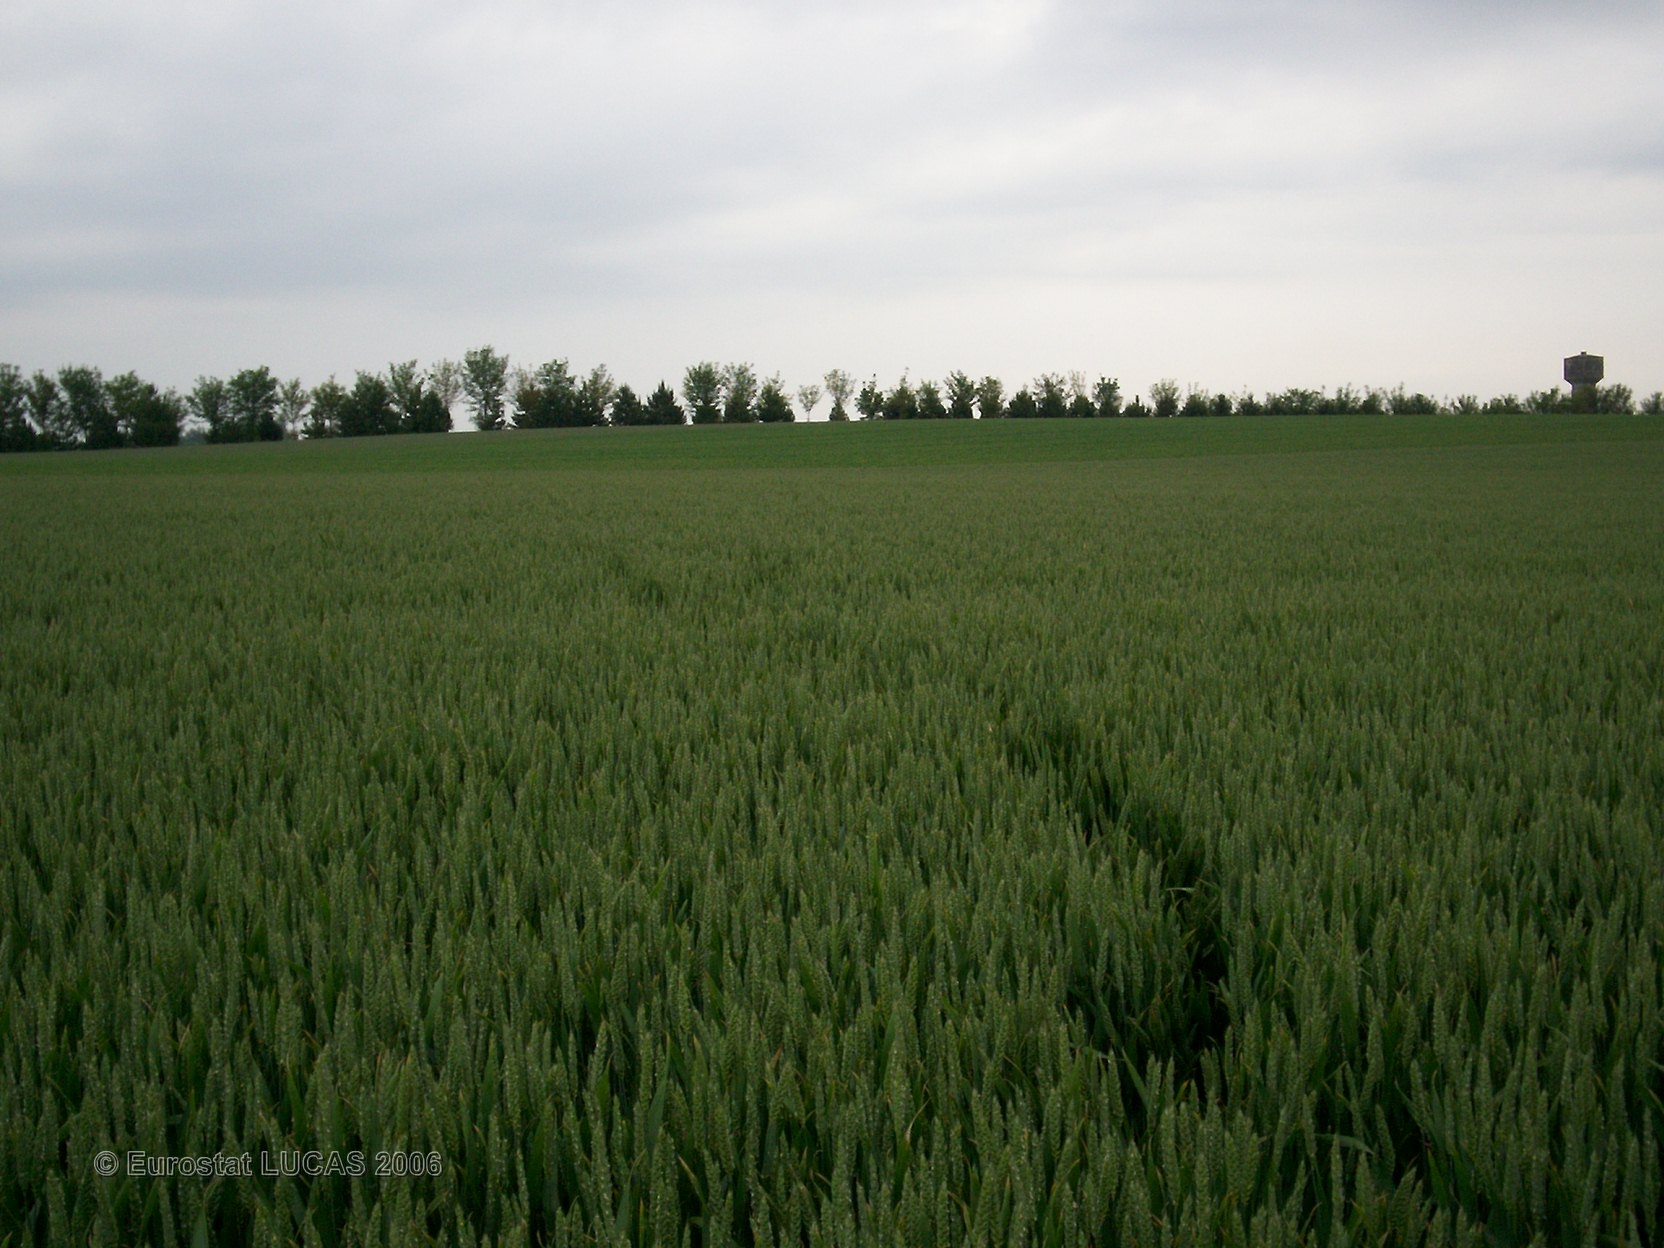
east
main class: Cropland
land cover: Common wheat
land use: Agriculture (excluding fallow land and kitchen gardens)
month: June
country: FR
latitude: 48.7529
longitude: 4.4882
